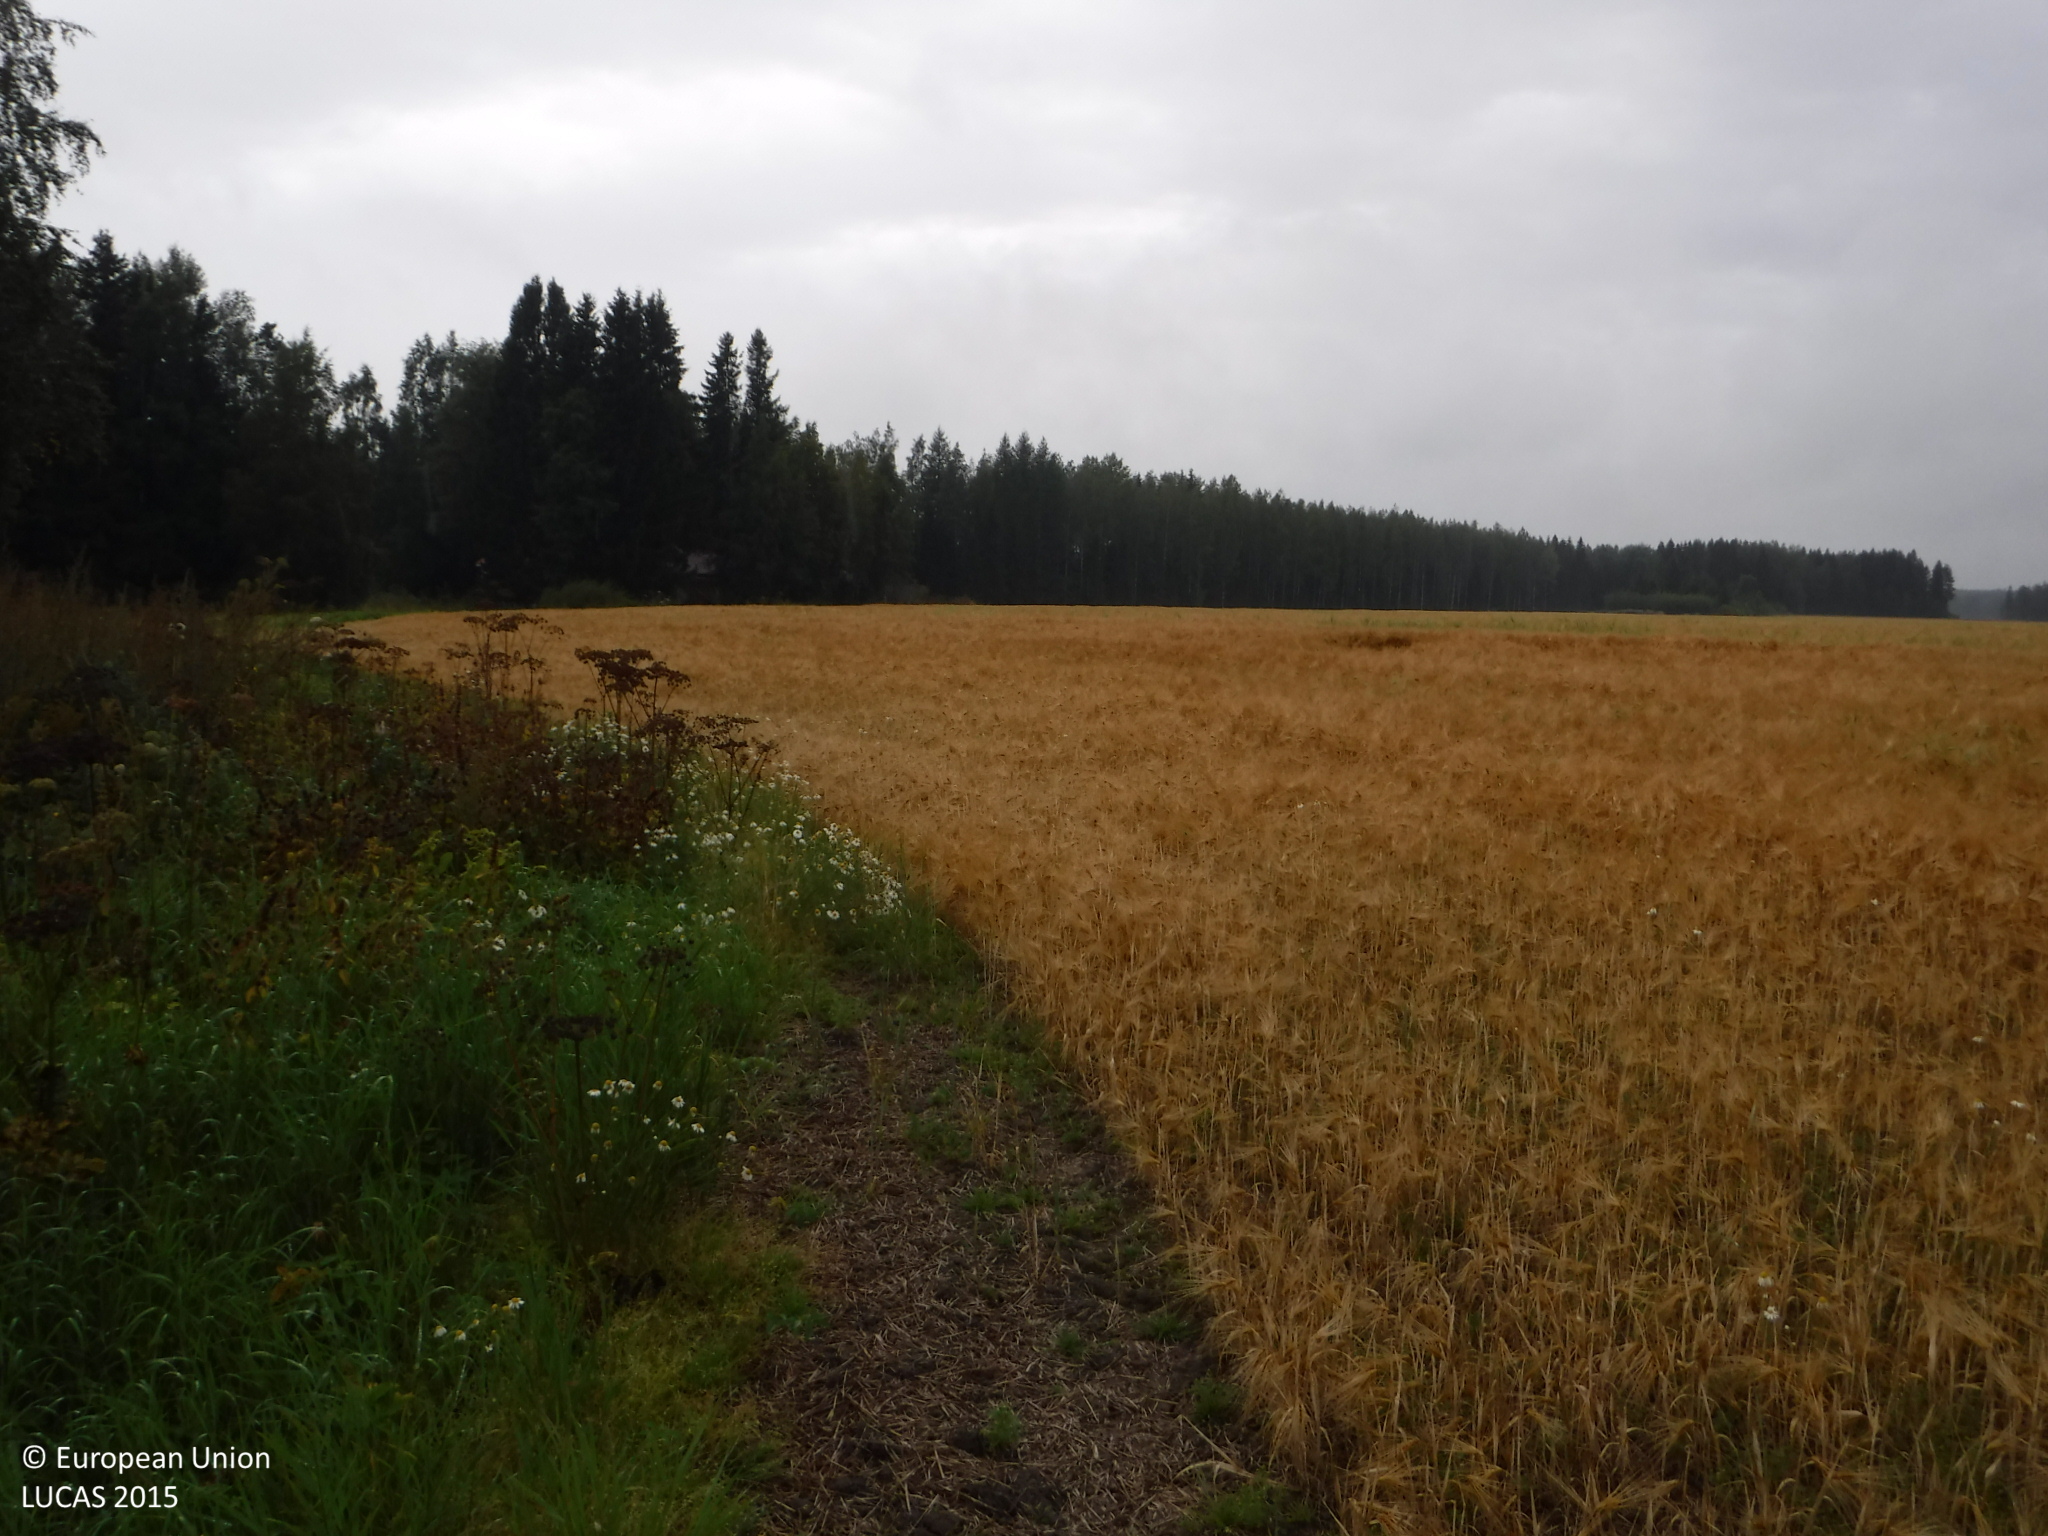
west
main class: Cropland
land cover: Barley
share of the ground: > 75 %
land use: Agriculture (excluding fallow land and kitchen gardens)
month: August
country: FI
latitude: 61.2095
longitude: 22.9340
